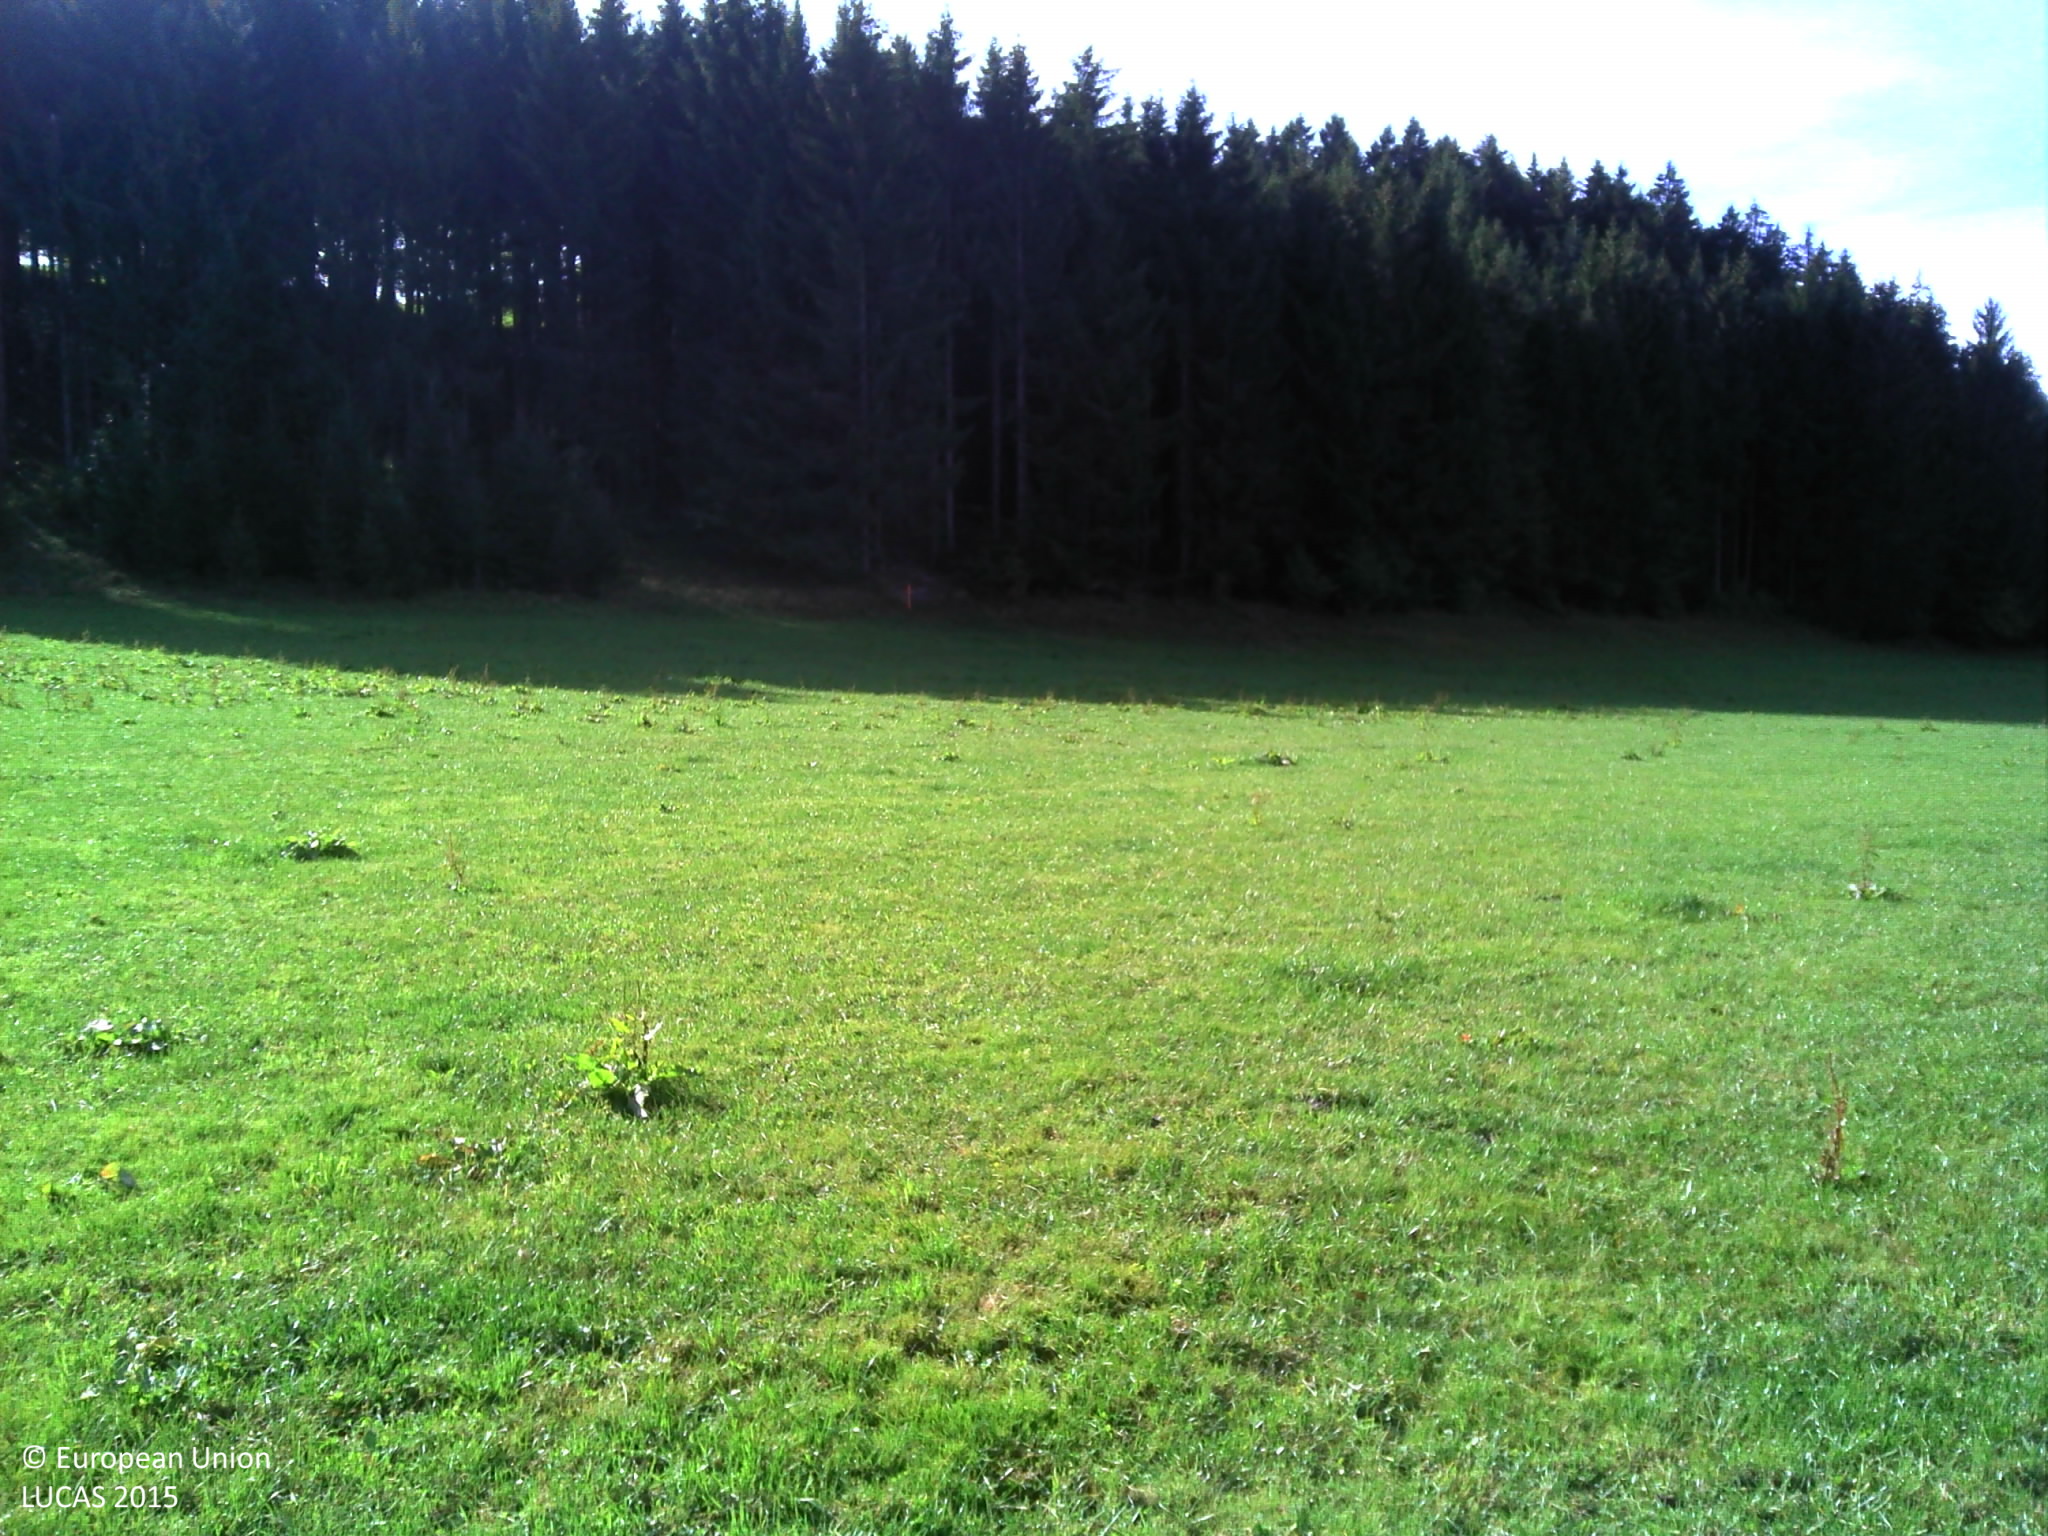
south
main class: Grassland
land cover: Grassland without tree/shrub cover
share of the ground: > 75 %
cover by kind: herbaceous plants 100 %
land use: Agriculture (excluding fallow land and kitchen gardens)
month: October
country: FR
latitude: 47.0625
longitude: 6.3024
